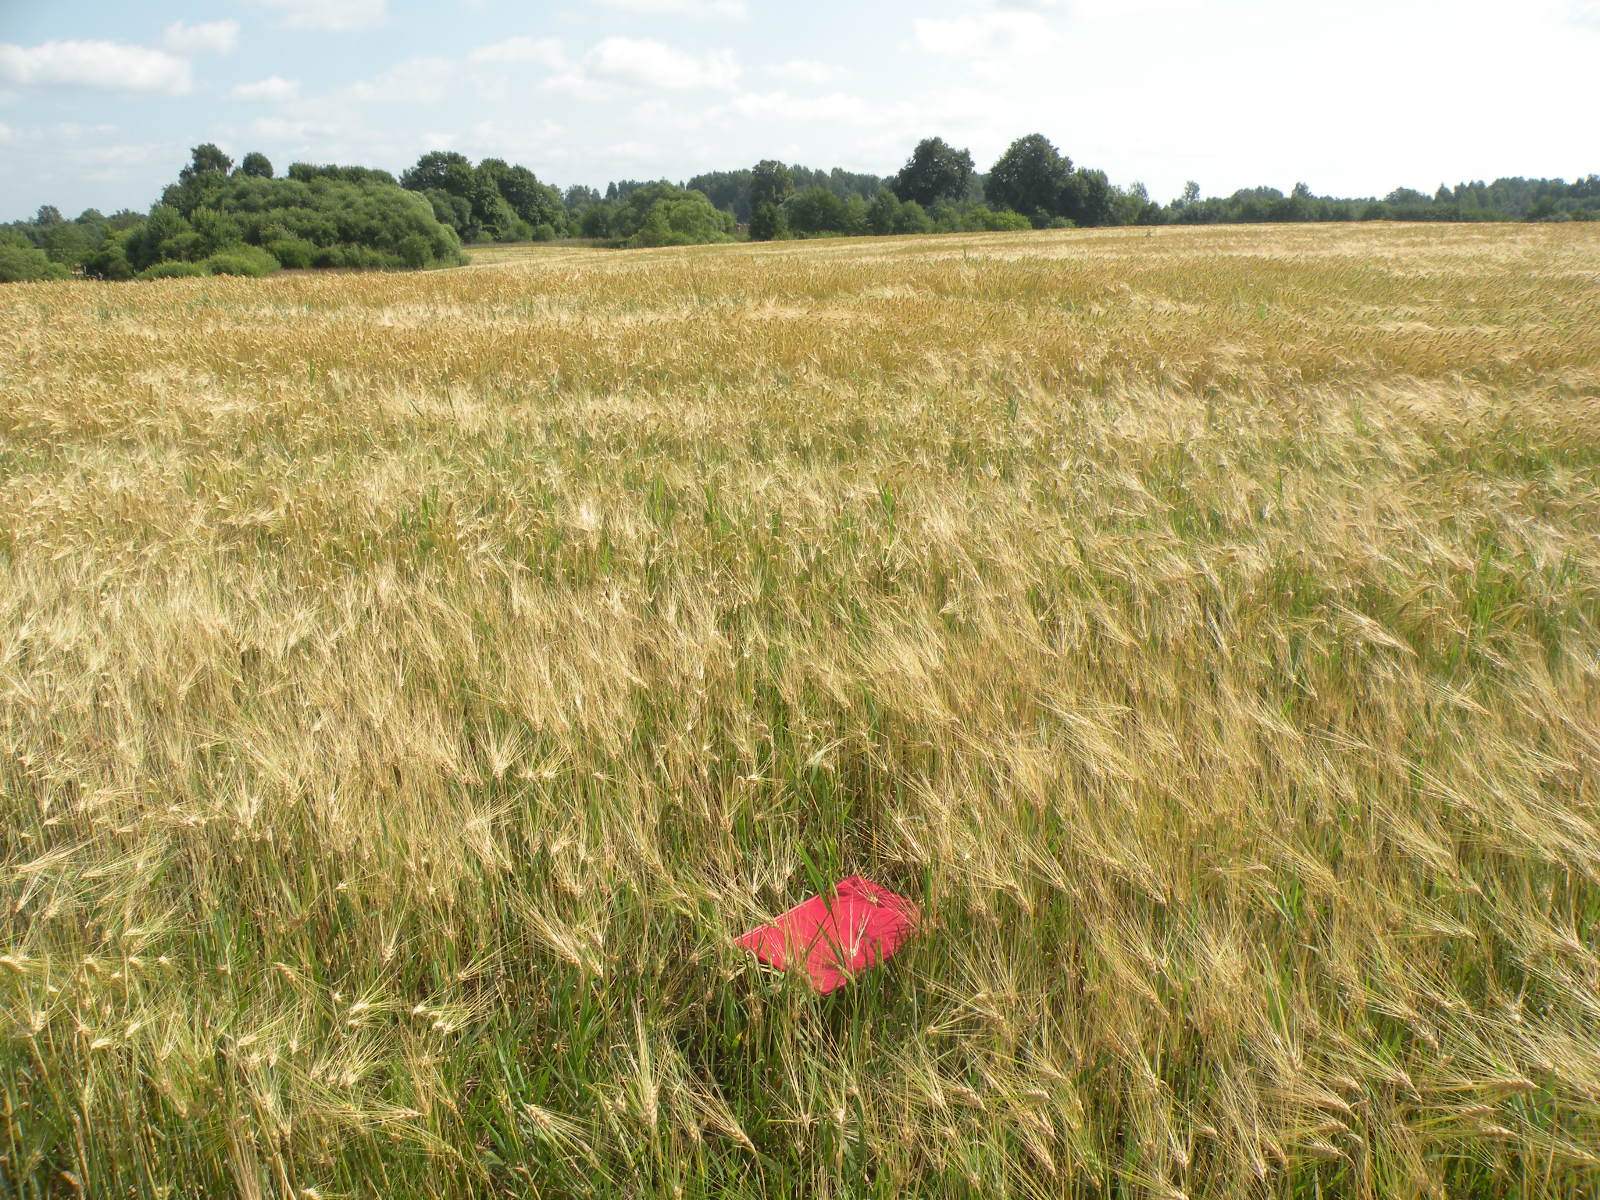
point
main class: Cropland
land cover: Barley
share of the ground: > 75 %
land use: Agriculture (excluding fallow land and kitchen gardens)
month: July
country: LV
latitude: 55.8518
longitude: 26.7220
